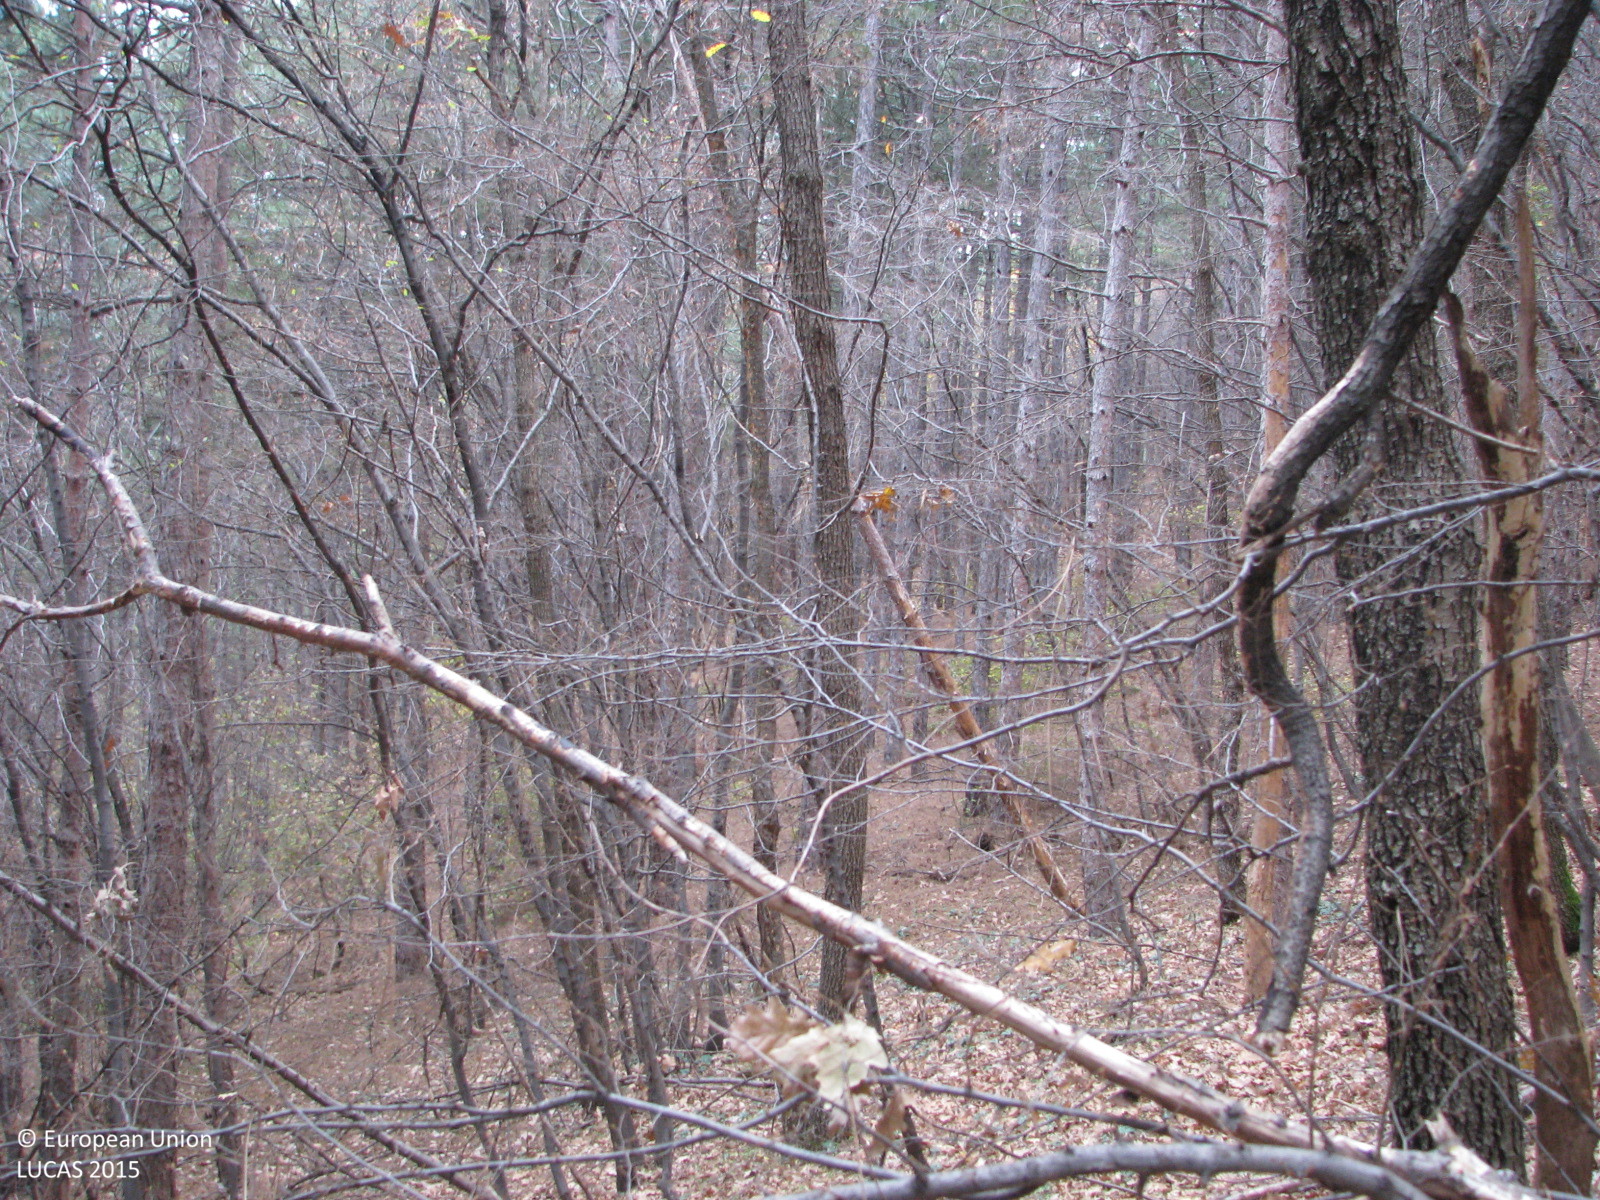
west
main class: Woodland
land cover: Pine dominated mixed woodland
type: hemiboreal forest and nemoral coniferous forest and mixed broadleaved-coniferous forest
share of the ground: > 75 %
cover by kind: coniferous forest trees 60 %, broadleaved forest trees 30 %, unconsolidated bare surface 10 %
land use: Forestry
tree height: > 5 m
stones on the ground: < 10 %
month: December
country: BG
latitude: 42.2949
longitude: 24.0255
